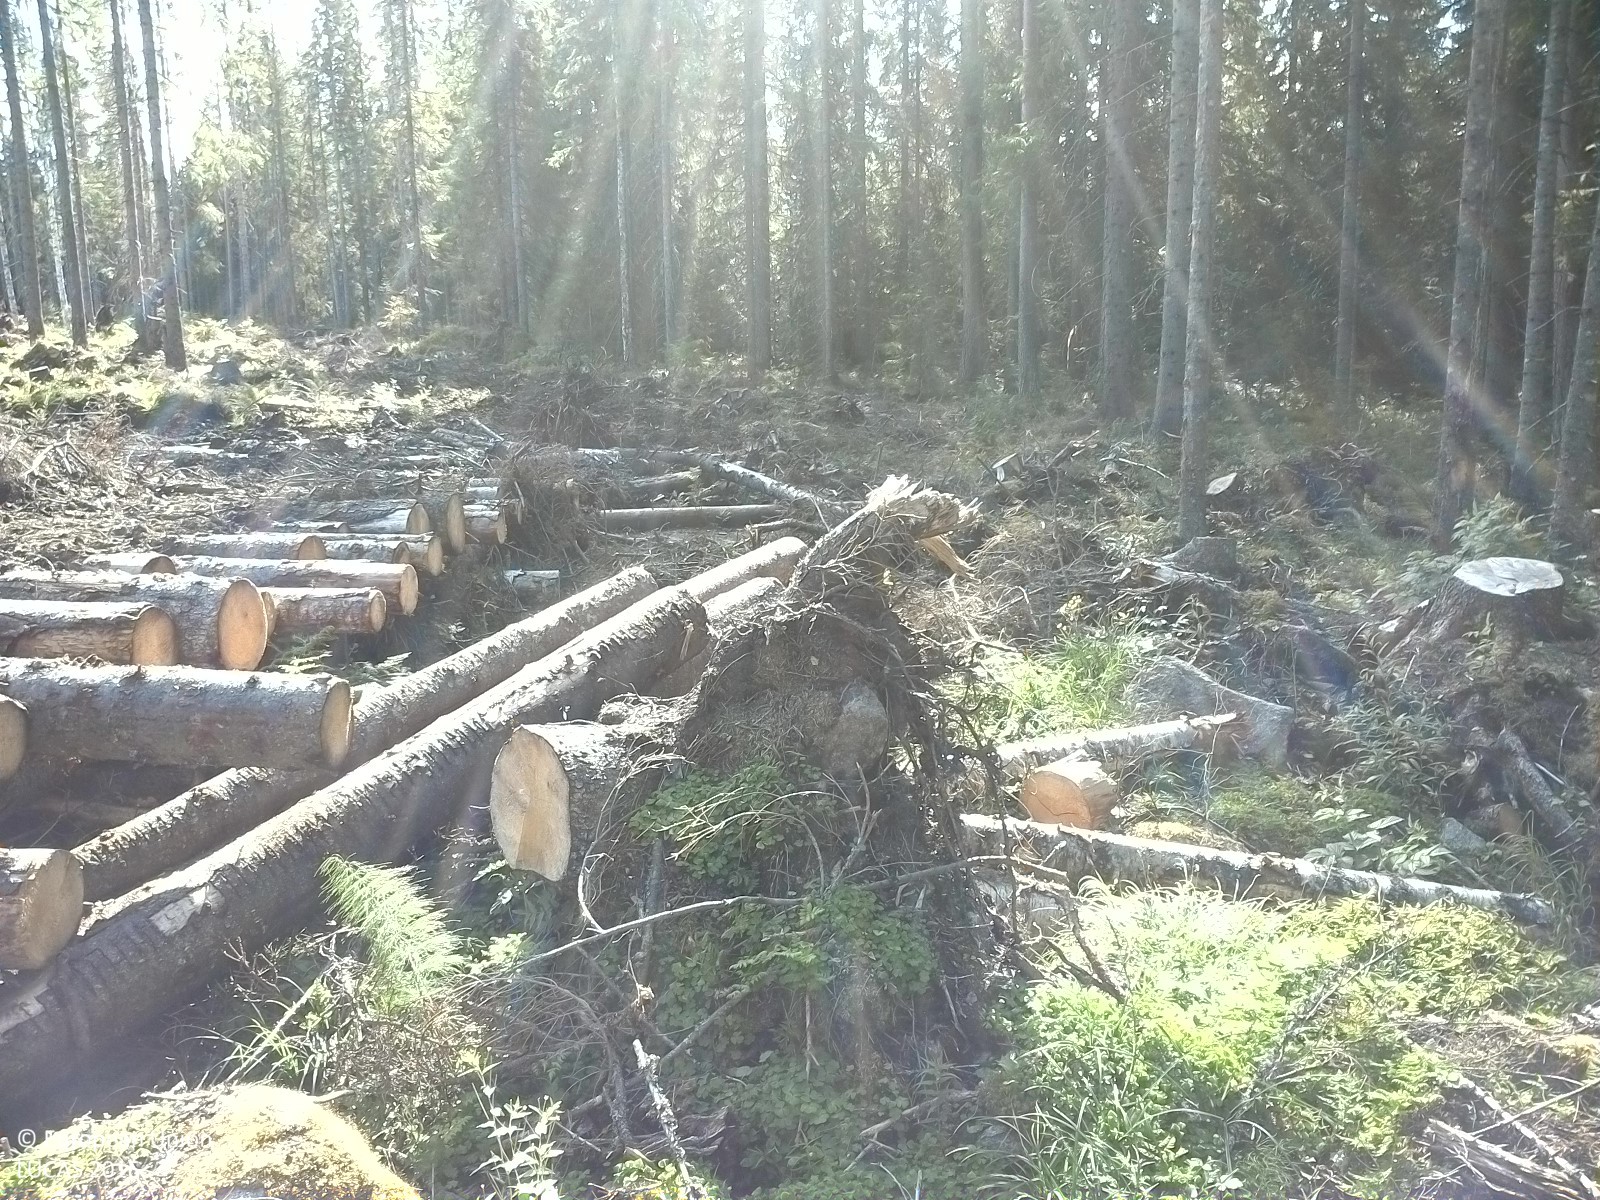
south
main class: Woodland
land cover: Spruce dominated coniferous woodland
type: boreal forest
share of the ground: 10 - 25 %
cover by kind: herbaceous plants 30 %, unconsolidated bare surface 25 %, coniferous forest trees 15 %, shrubs 15 %, lichens and mosses 15 %
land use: Forestry
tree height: > 5 m
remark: Clear cut
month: August
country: SE
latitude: 62.5806
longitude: 16.4996
